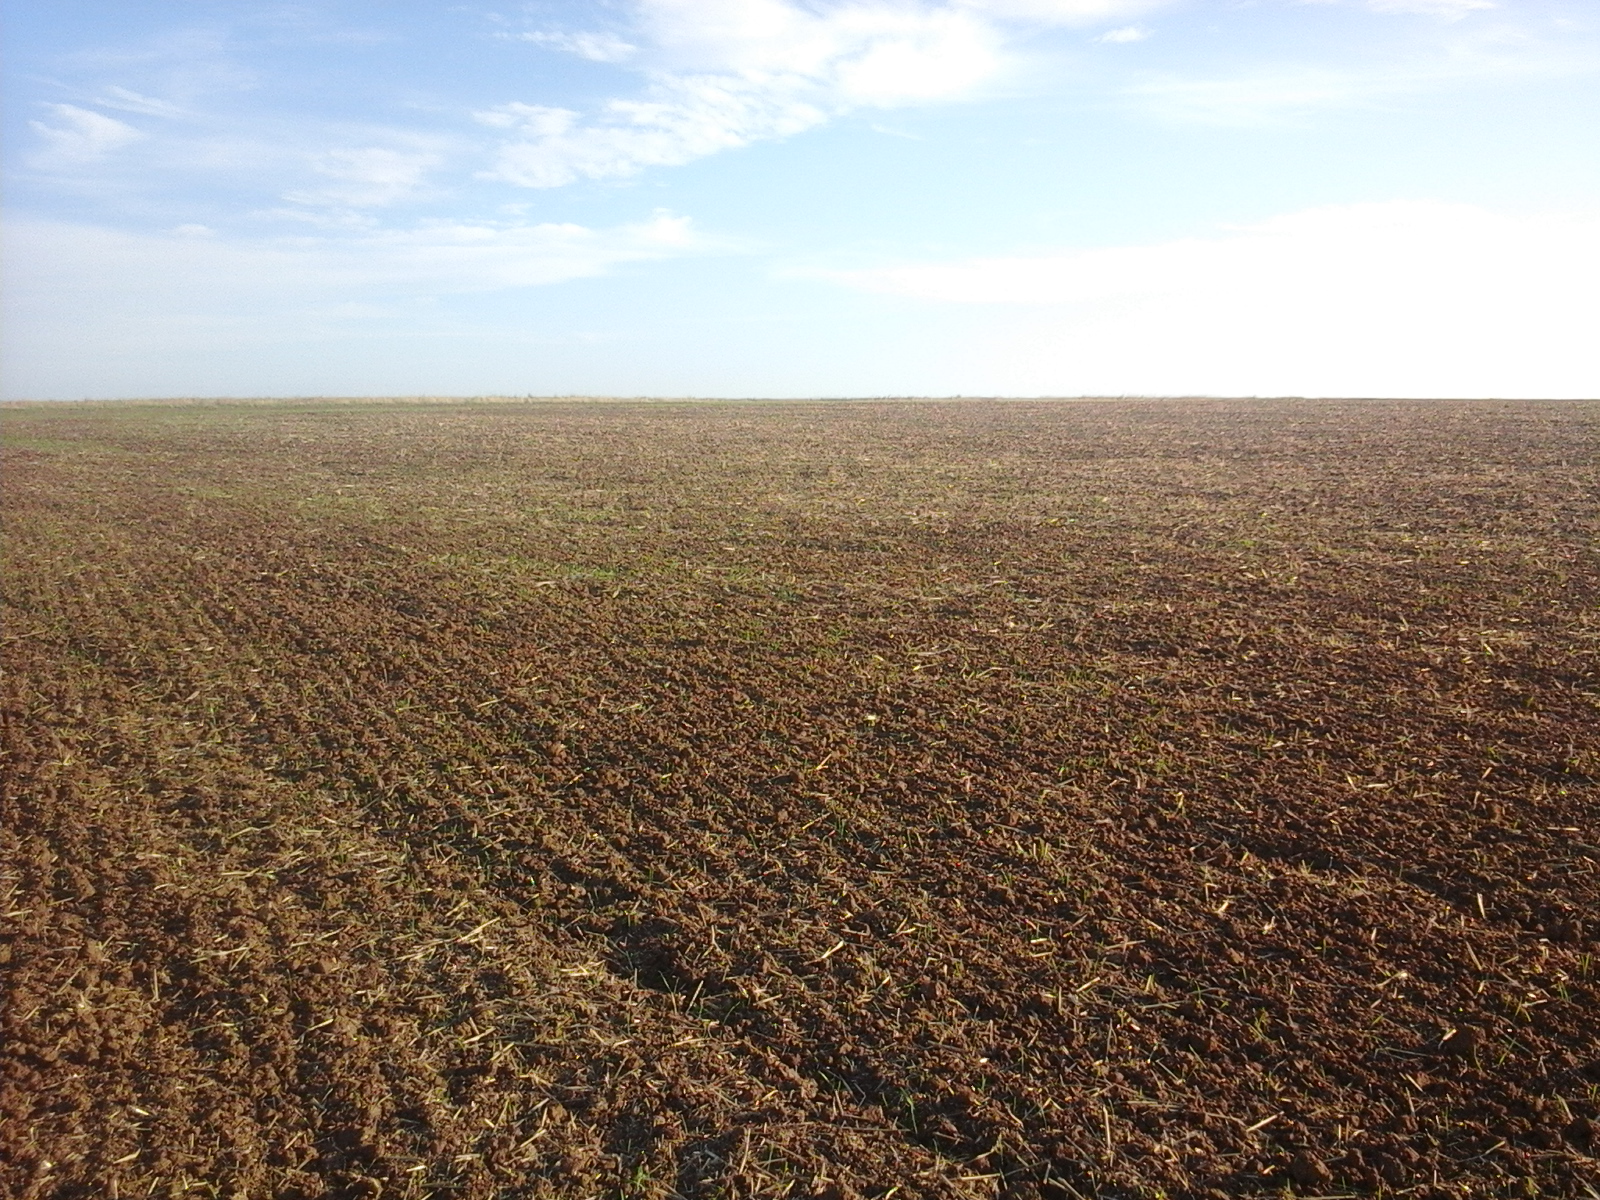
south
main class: Cropland
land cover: Common wheat
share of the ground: 10 - 25 %
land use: Agriculture (excluding fallow land and kitchen gardens)
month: August
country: RO
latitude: 46.0015
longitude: 21.3318
